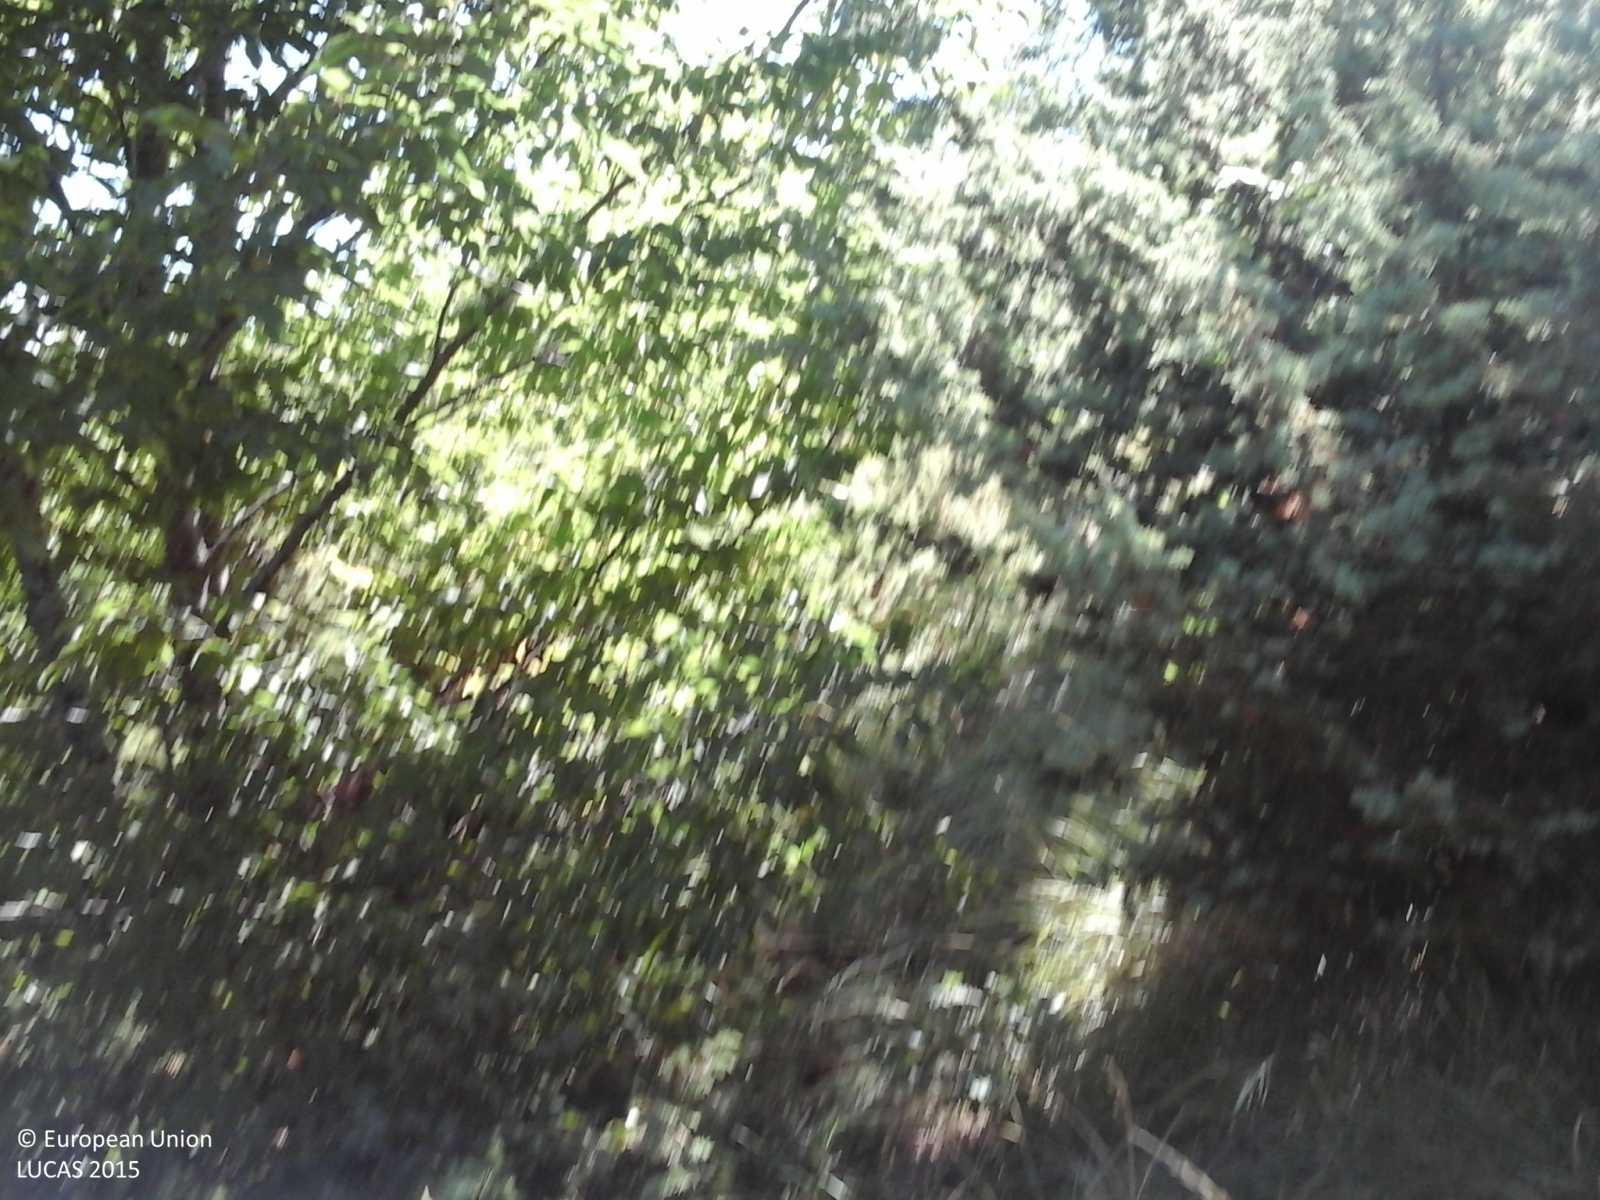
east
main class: Woodland
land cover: Broadleaved woodland
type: thermophilous deciduous forest
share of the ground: > 75 %
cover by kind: broadleaved forest trees 95 %, coniferous forest trees 5 %
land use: Forestry
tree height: > 5 m
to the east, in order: Broadleaved woodland
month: August
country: IT
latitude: 43.2064
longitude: 12.9827
